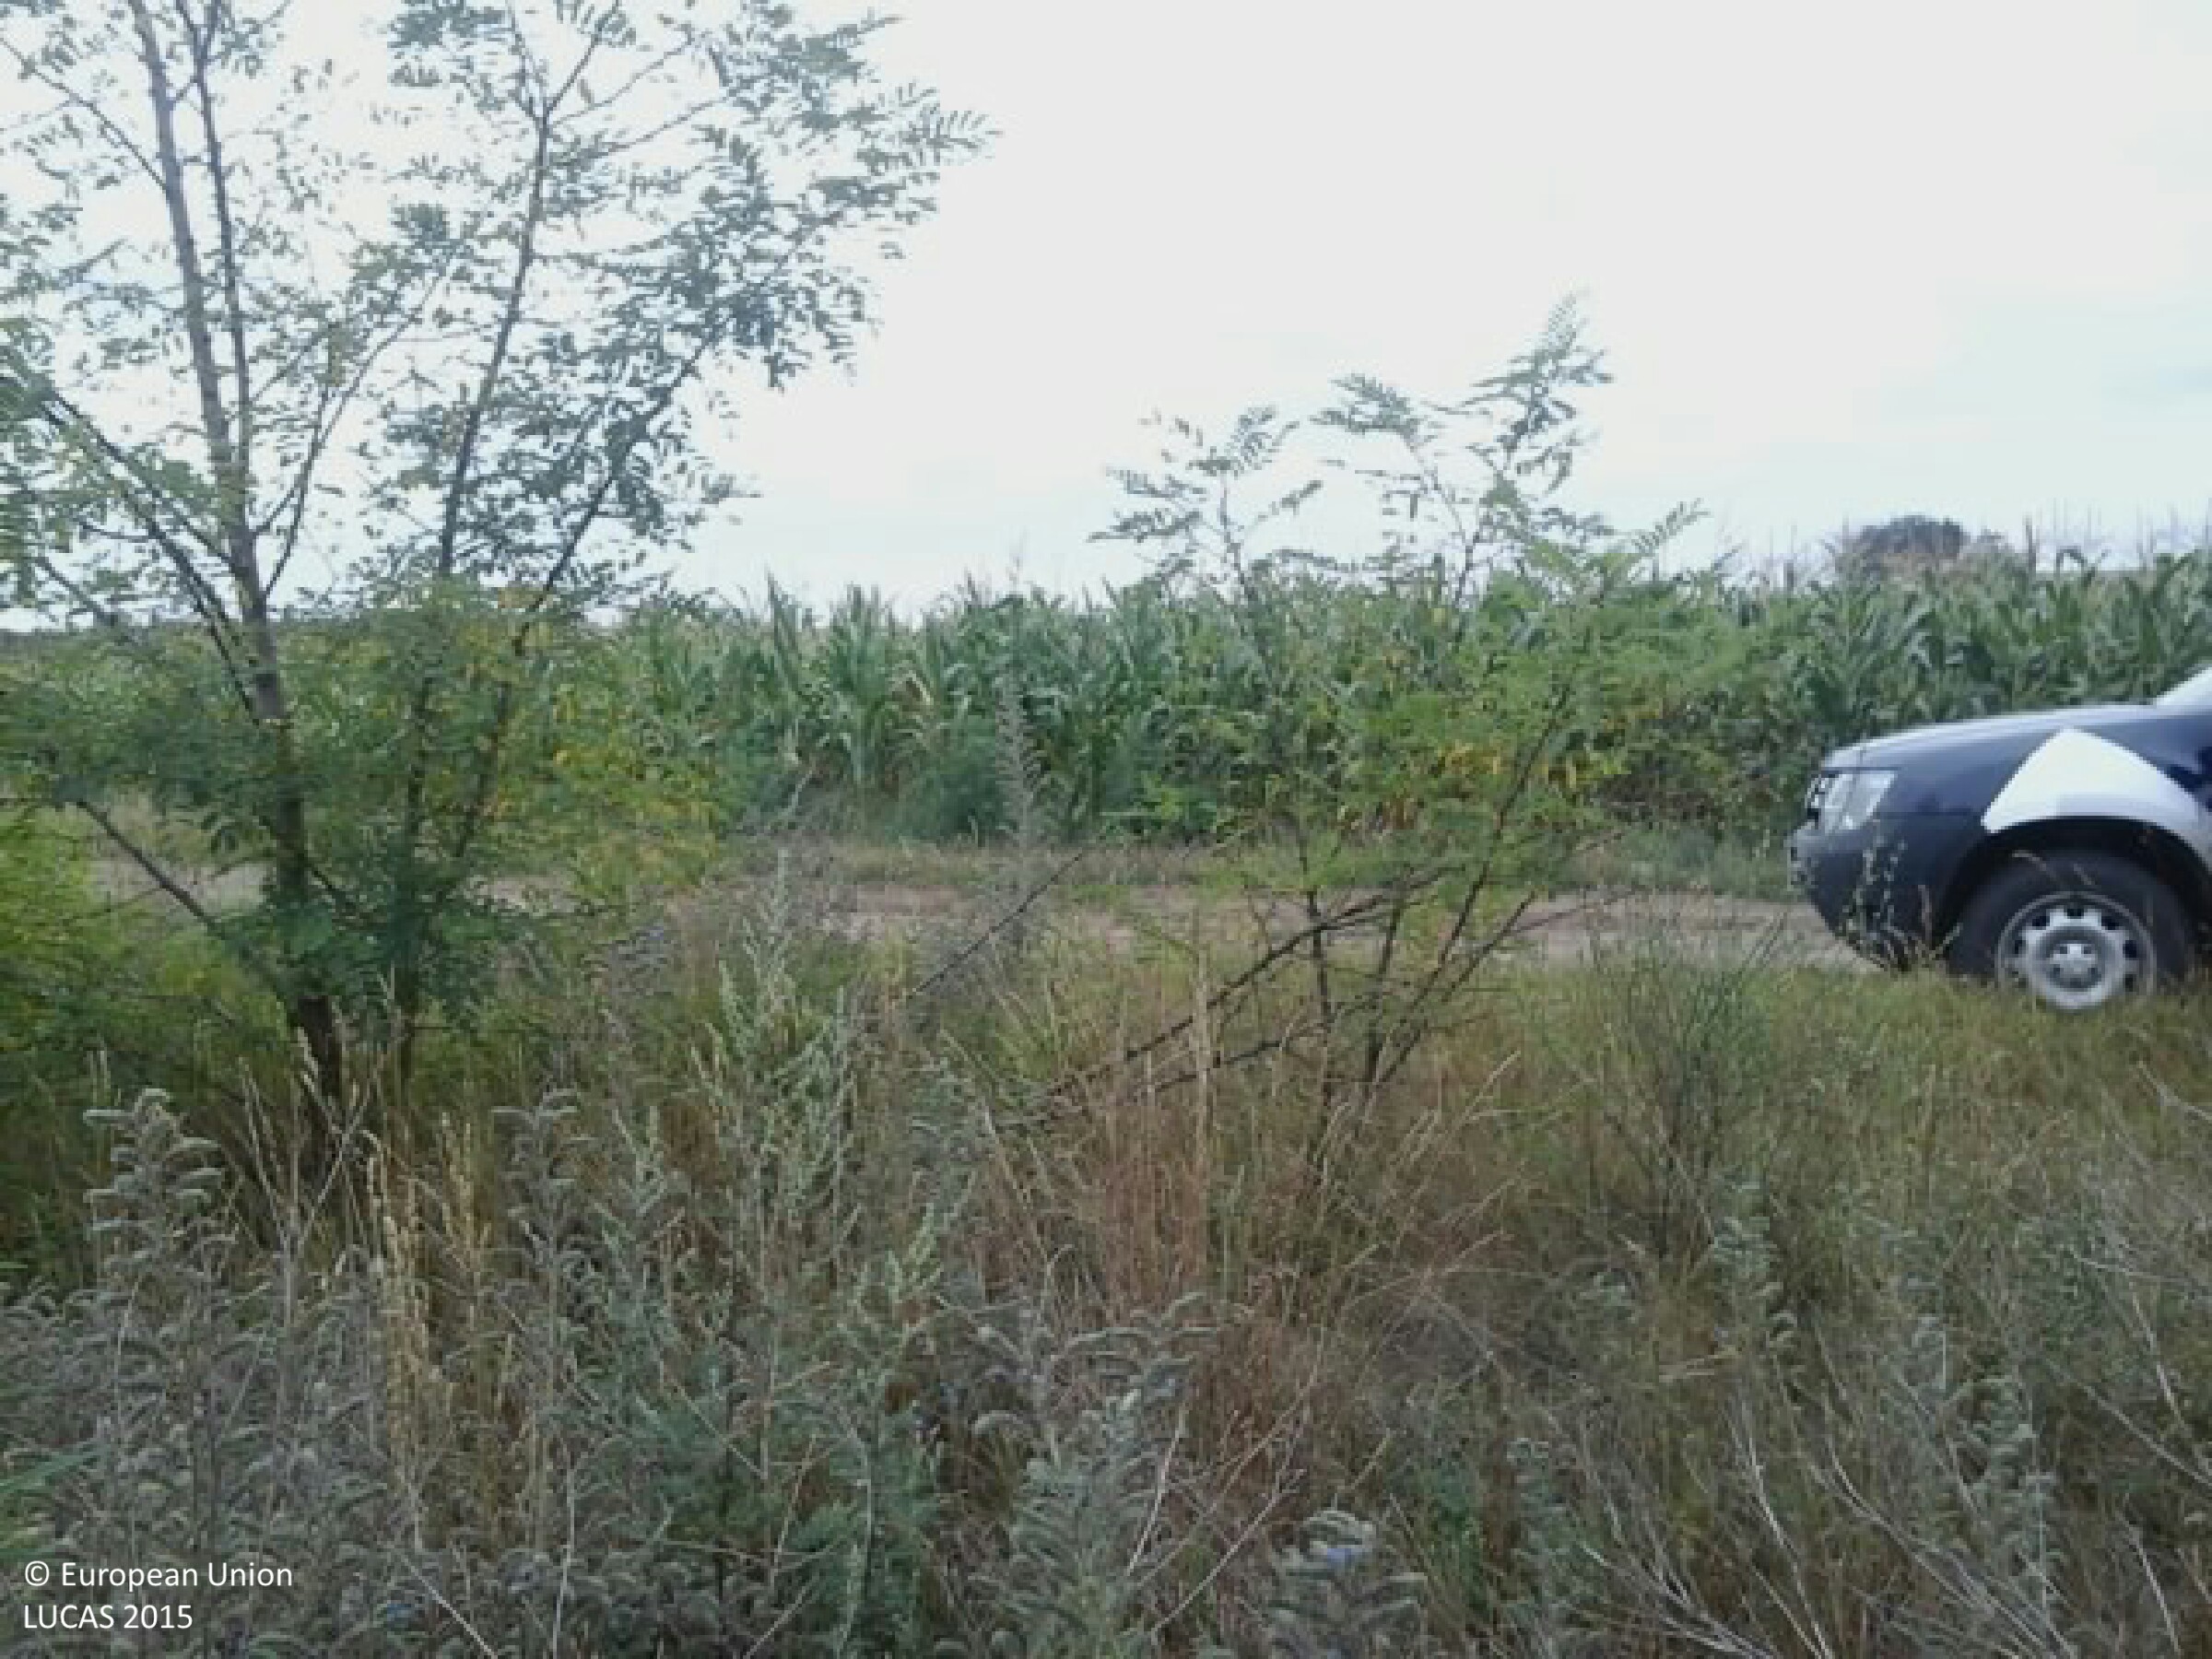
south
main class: Cropland
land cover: Maize
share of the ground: > 75 %
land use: Agriculture (excluding fallow land and kitchen gardens)
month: July
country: HU
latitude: 46.9760
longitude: 19.7358
